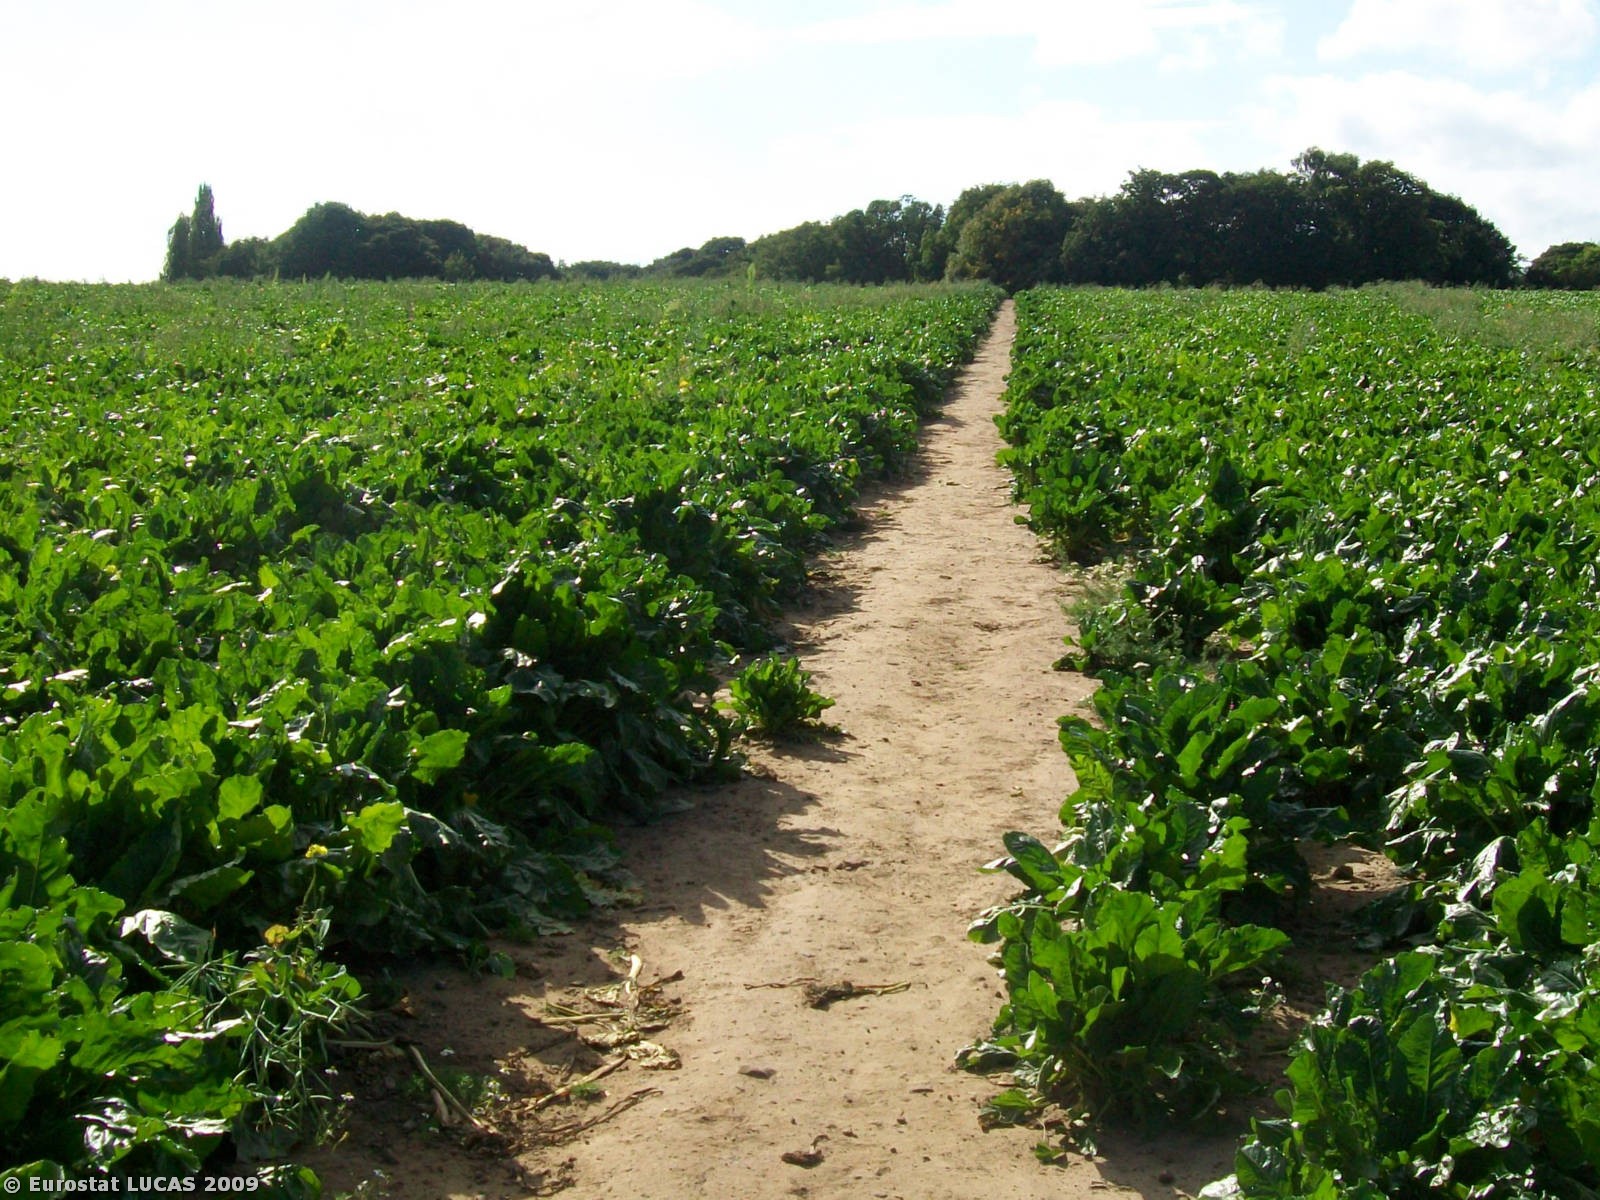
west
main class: Cropland
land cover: Other root crops
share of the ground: > 75 %
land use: Agriculture (excluding fallow land and kitchen gardens)
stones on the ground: 10 - 25 %
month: September
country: GB
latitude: 53.4554
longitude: -1.2664
